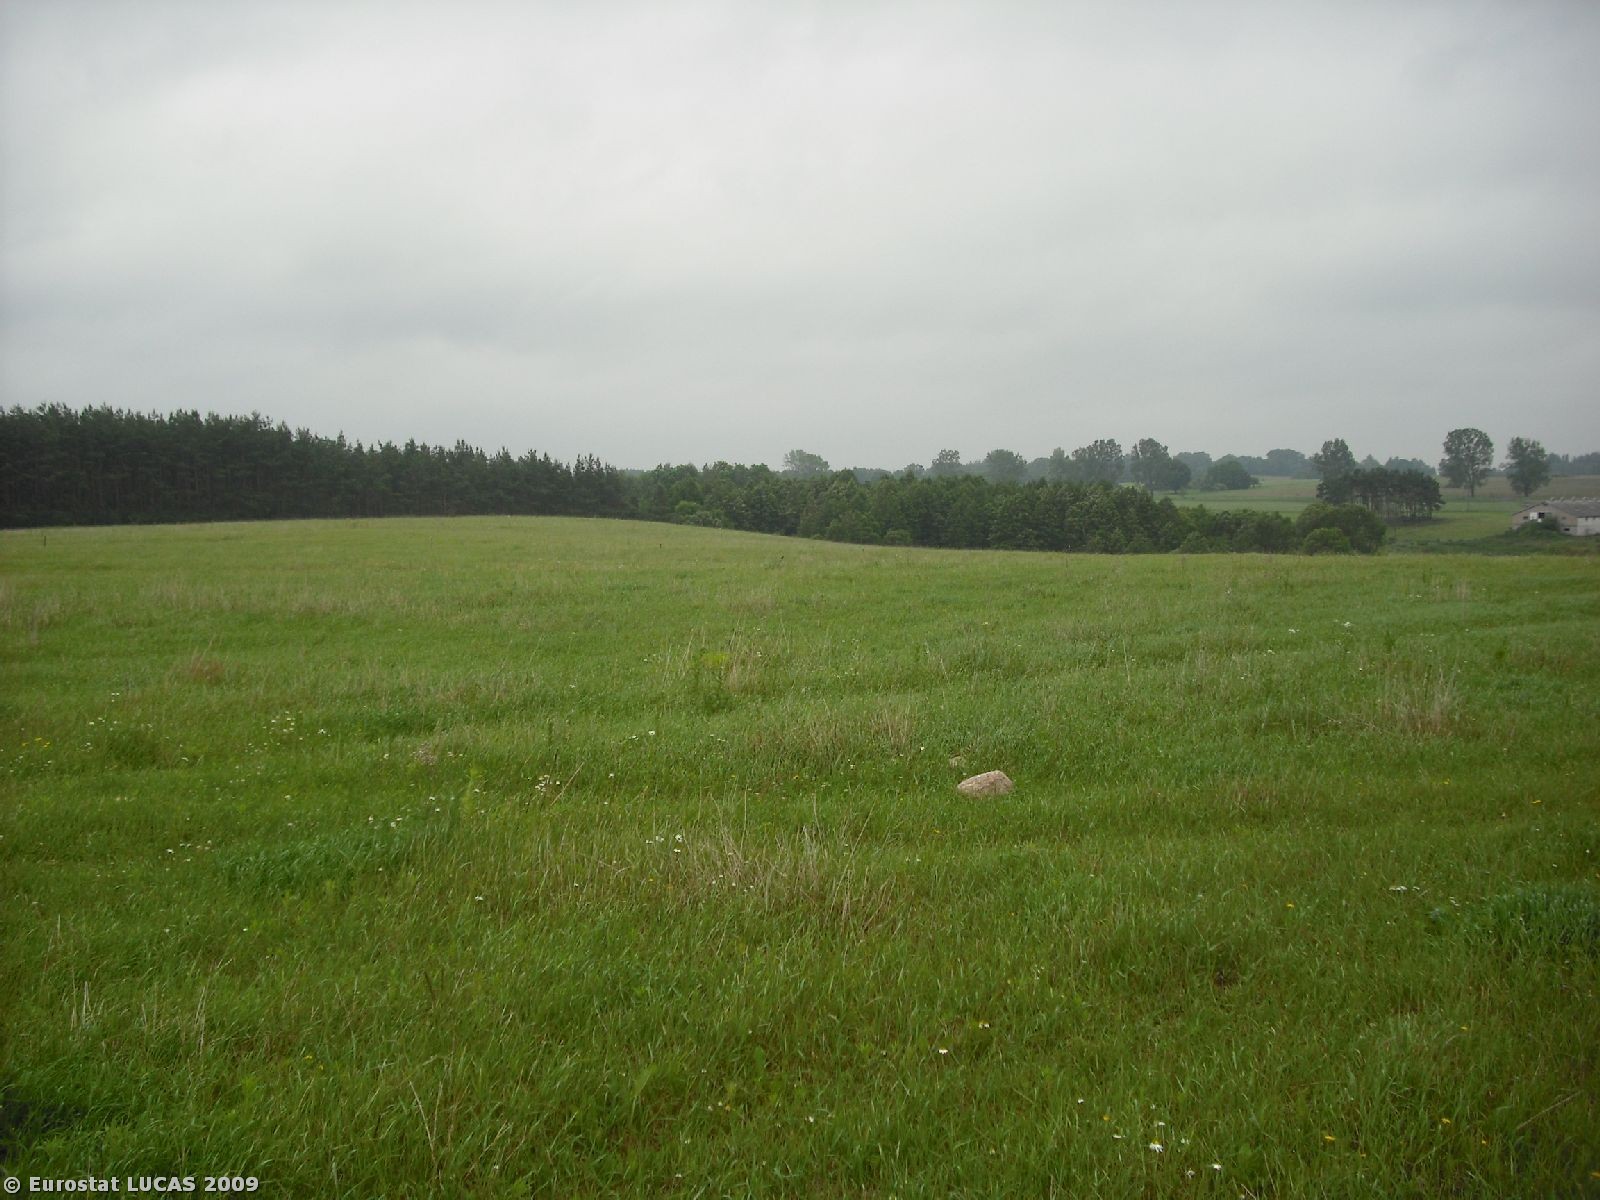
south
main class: Grassland
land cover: Grassland without tree/shrub cover
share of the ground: > 75 %
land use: Agriculture (excluding fallow land and kitchen gardens)
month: June
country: PL
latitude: 54.1379
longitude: 22.8201
